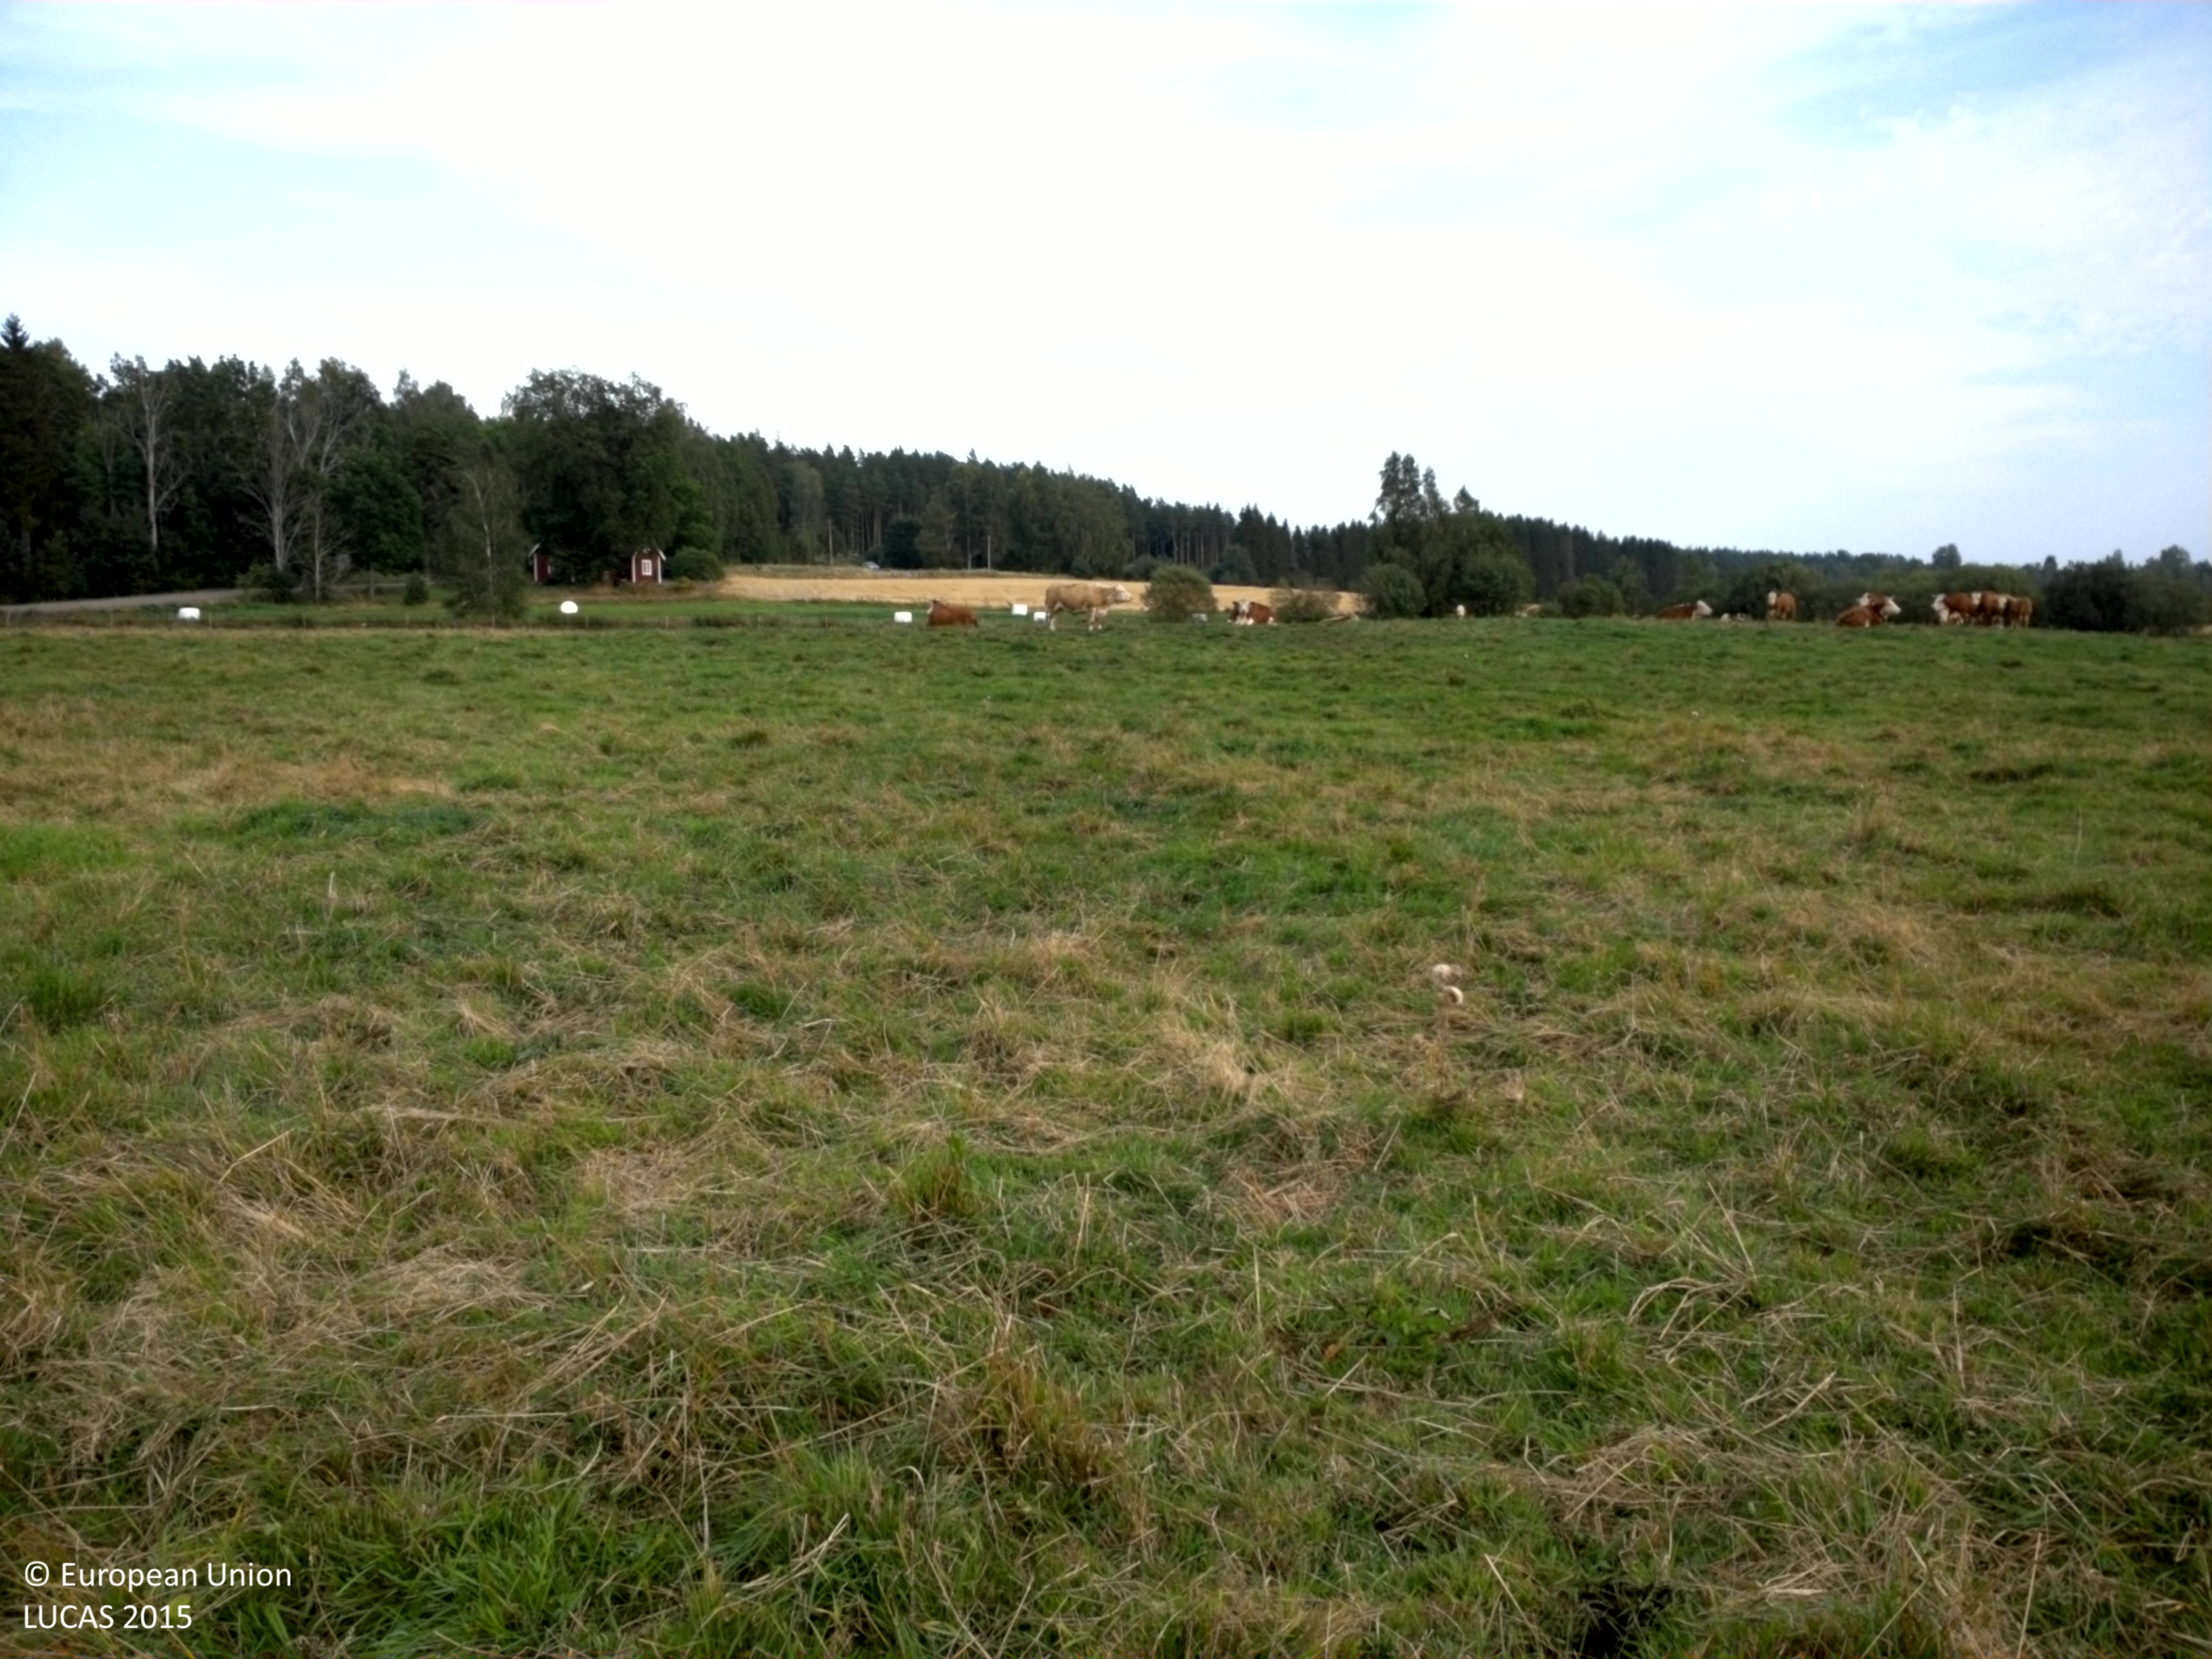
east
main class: Grassland
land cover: Grassland without tree/shrub cover
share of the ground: > 75 %
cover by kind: herbaceous plants 100 %
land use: Agriculture (excluding fallow land and kitchen gardens)
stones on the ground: < 10 %
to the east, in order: Grassland without tree/shrub cover; Ditches and canals; Grassland without tree/shrub cover; Fences; Grassland without tree/shrub cover; Fences; Grass margins; Paved roads, cycling and walking lanes
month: August
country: SE
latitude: 60.0129
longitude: 17.5809
